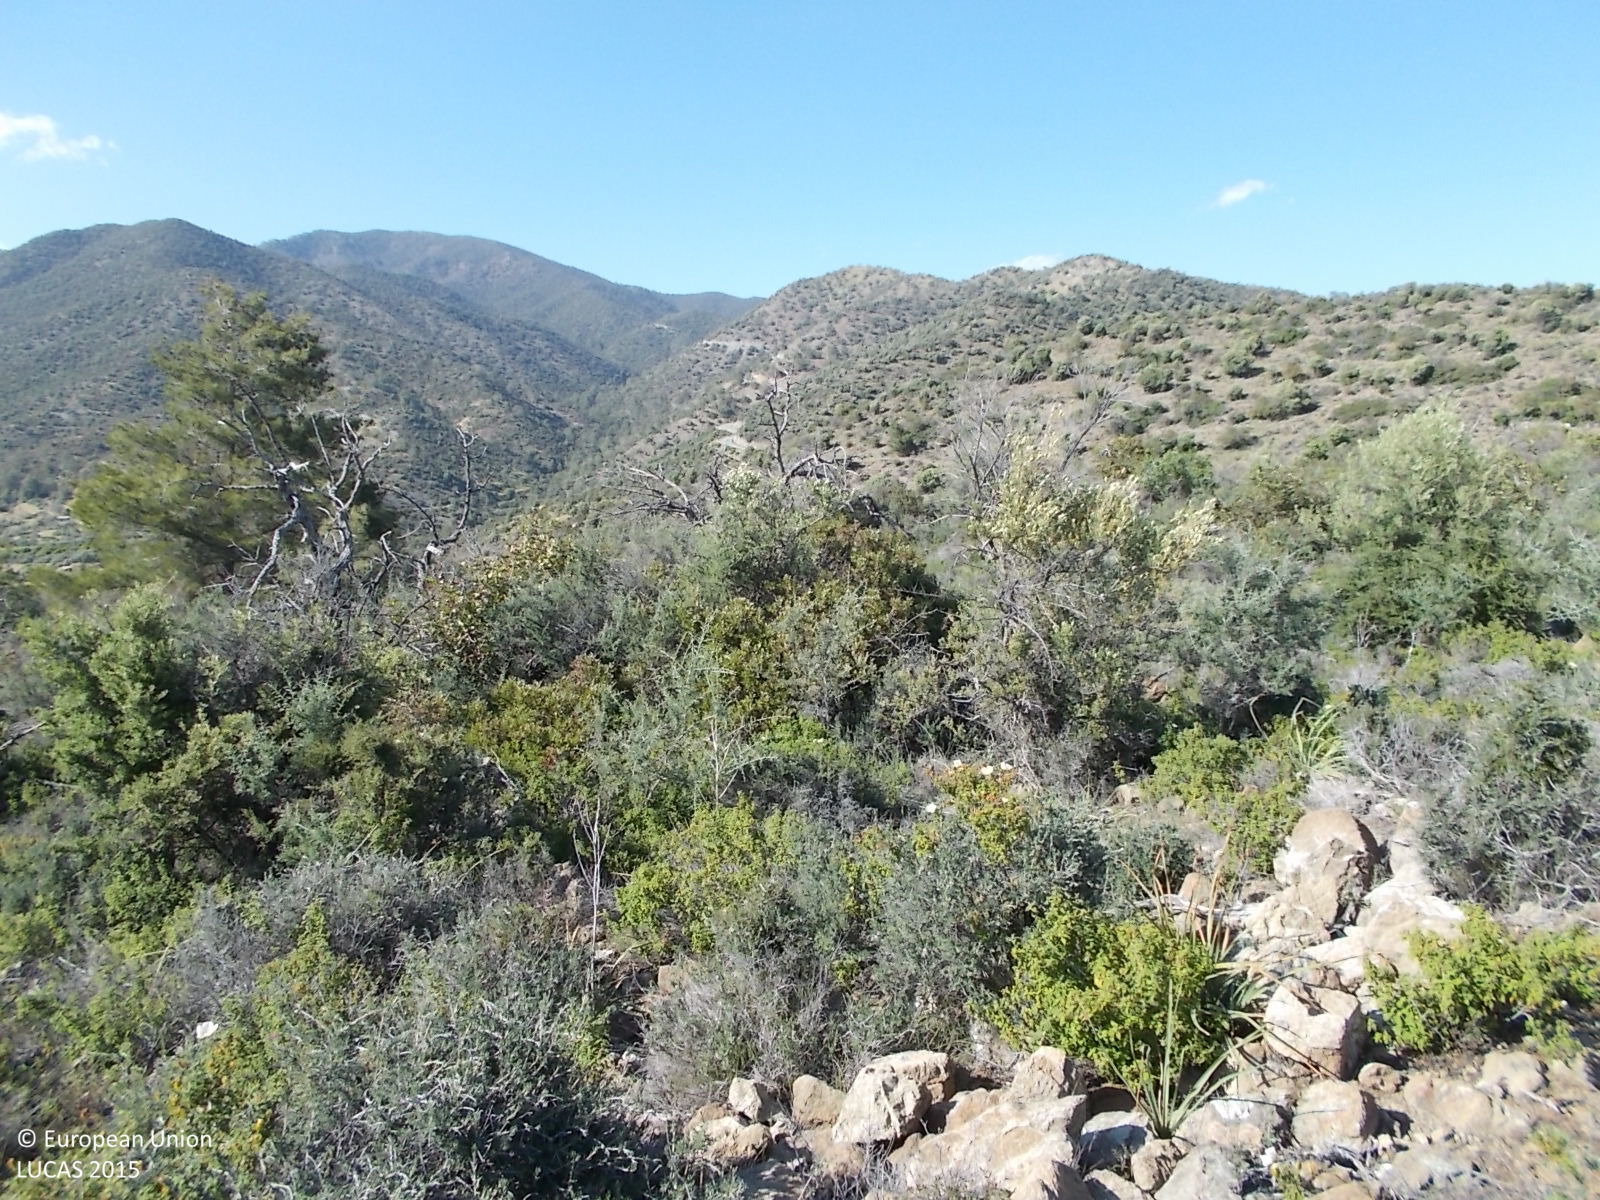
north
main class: Shrubland
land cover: Shrubland with sparse tree cover
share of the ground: > 75 %
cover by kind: shrubs 95 %, broadleaved forest trees 5 %
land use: Forestry
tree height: > 5 m
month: April
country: CY
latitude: 34.7728
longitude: 33.0826
